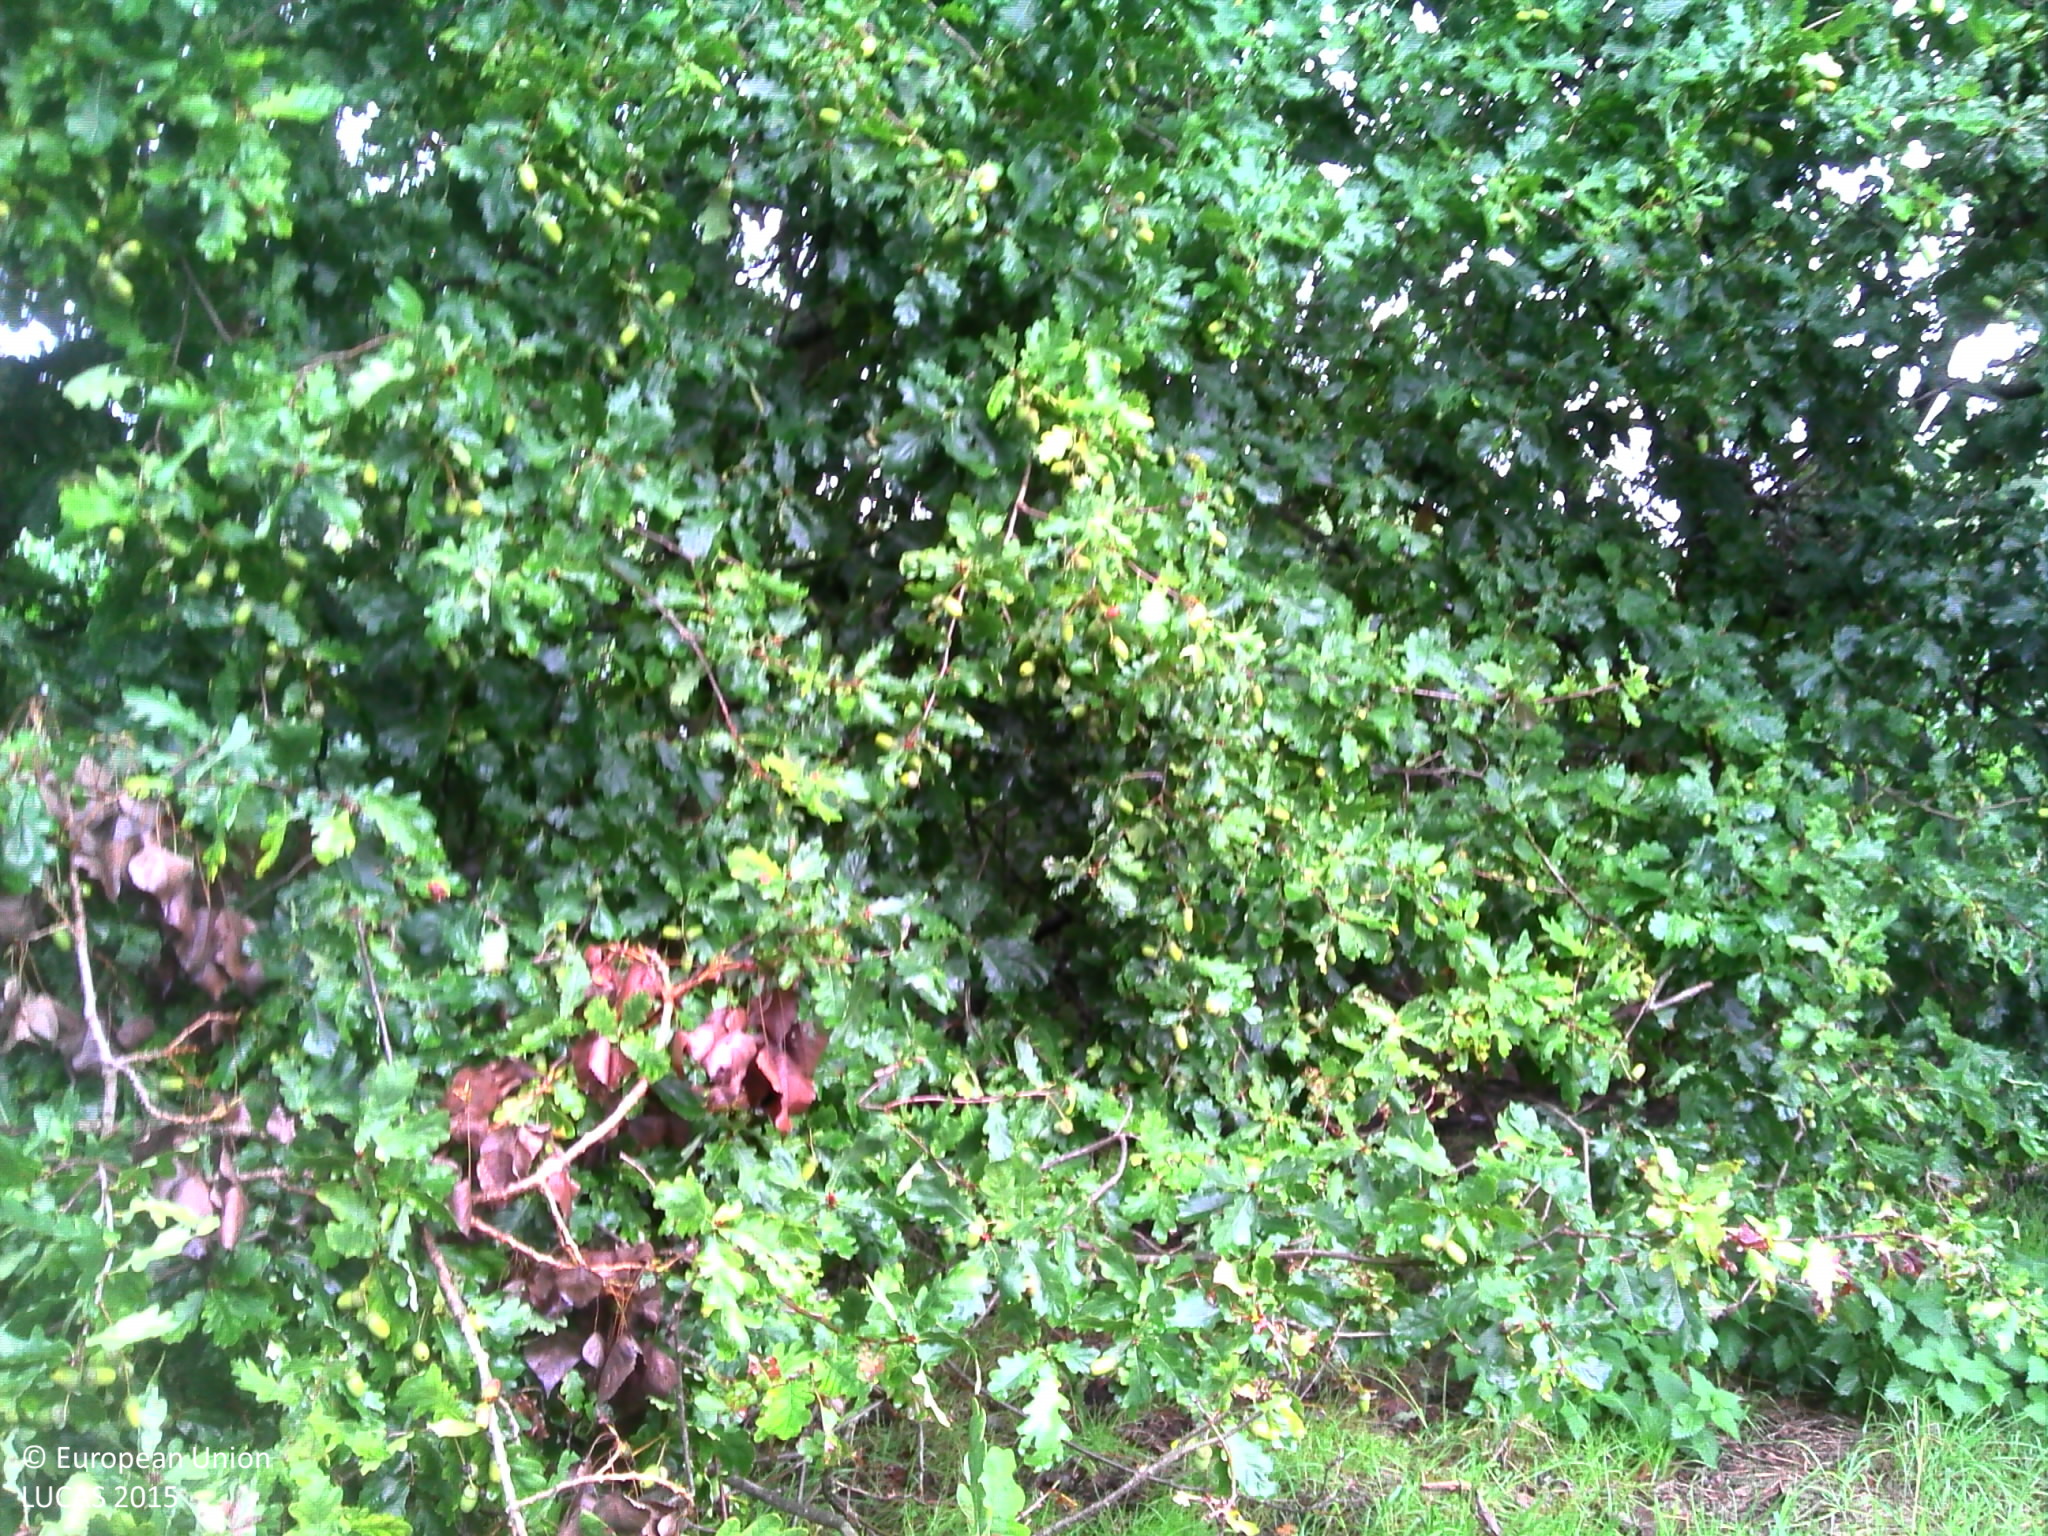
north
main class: Grassland
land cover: Grassland without tree/shrub cover
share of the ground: > 75 %
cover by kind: herbaceous plants 100 %
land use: Agriculture (excluding fallow land and kitchen gardens)
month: September
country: BE
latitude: 51.2481
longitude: 4.6524
